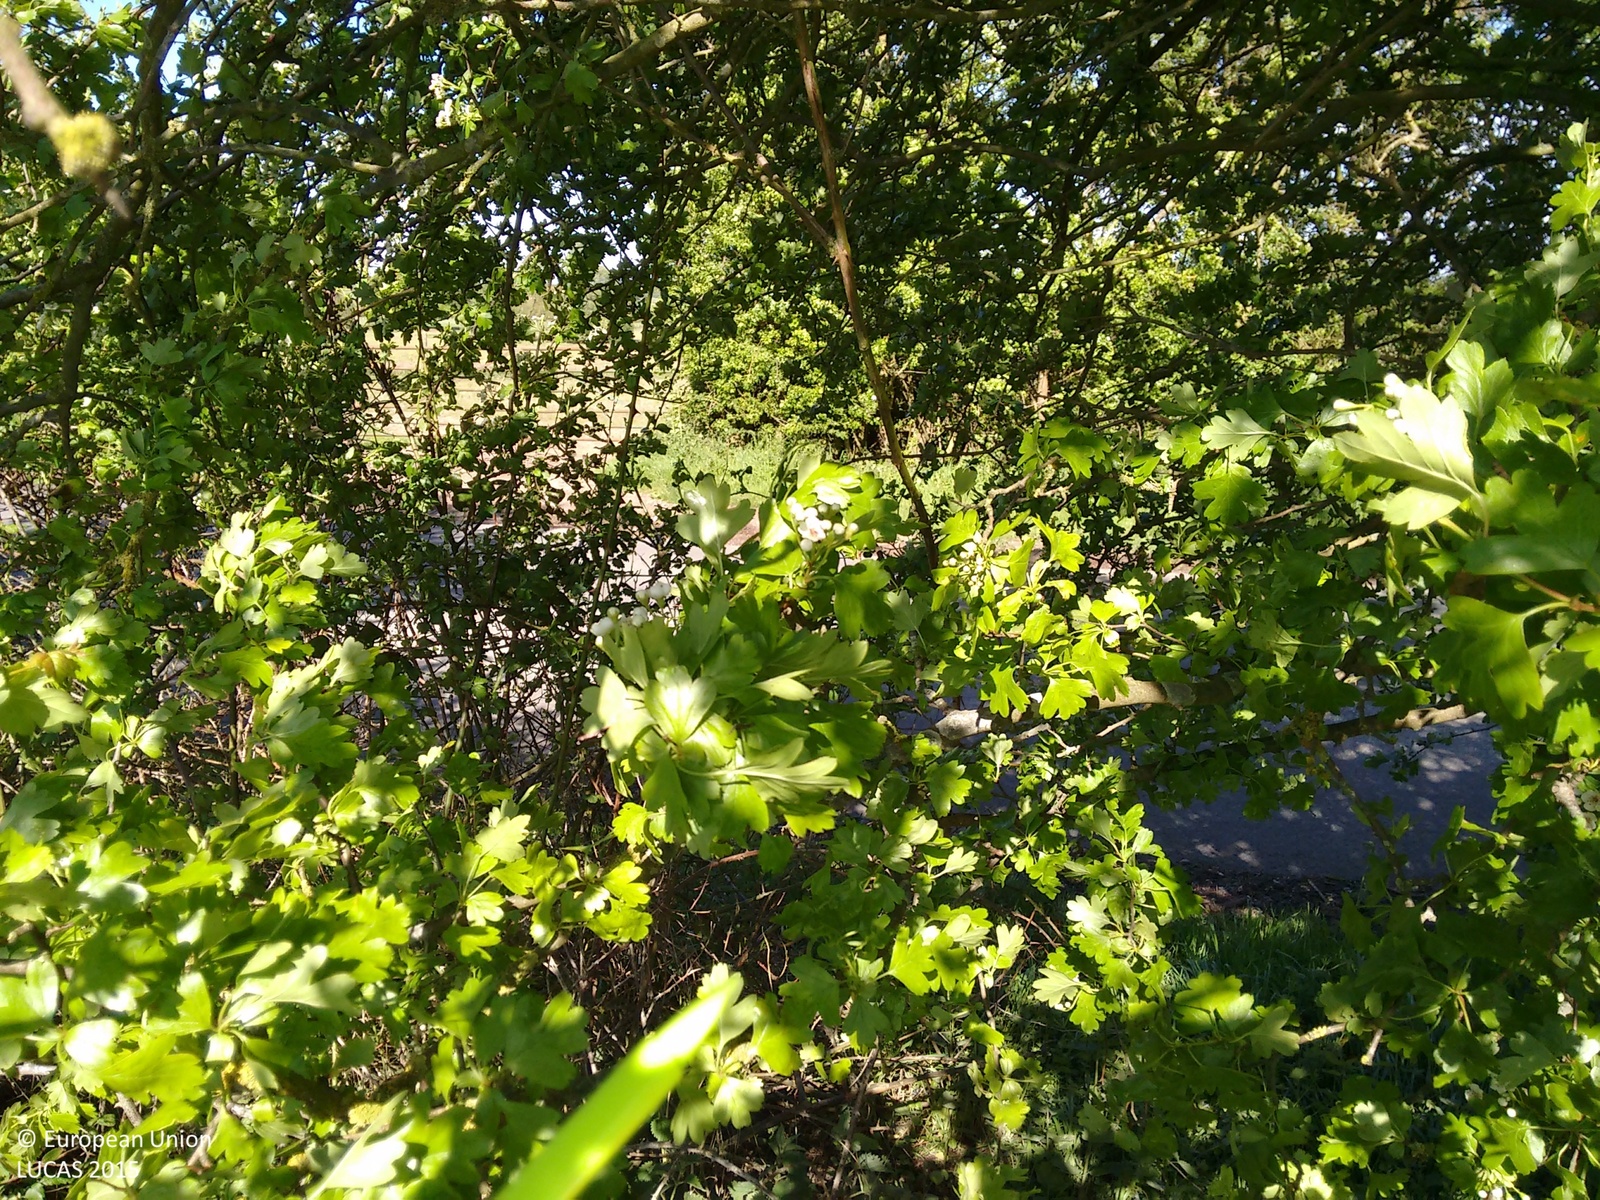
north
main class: Grassland
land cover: Grassland without tree/shrub cover
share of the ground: > 75 %
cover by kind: herbaceous plants 100 %
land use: Agriculture (excluding fallow land and kitchen gardens)
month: May
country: GB
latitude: 52.2510
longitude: -1.6991
